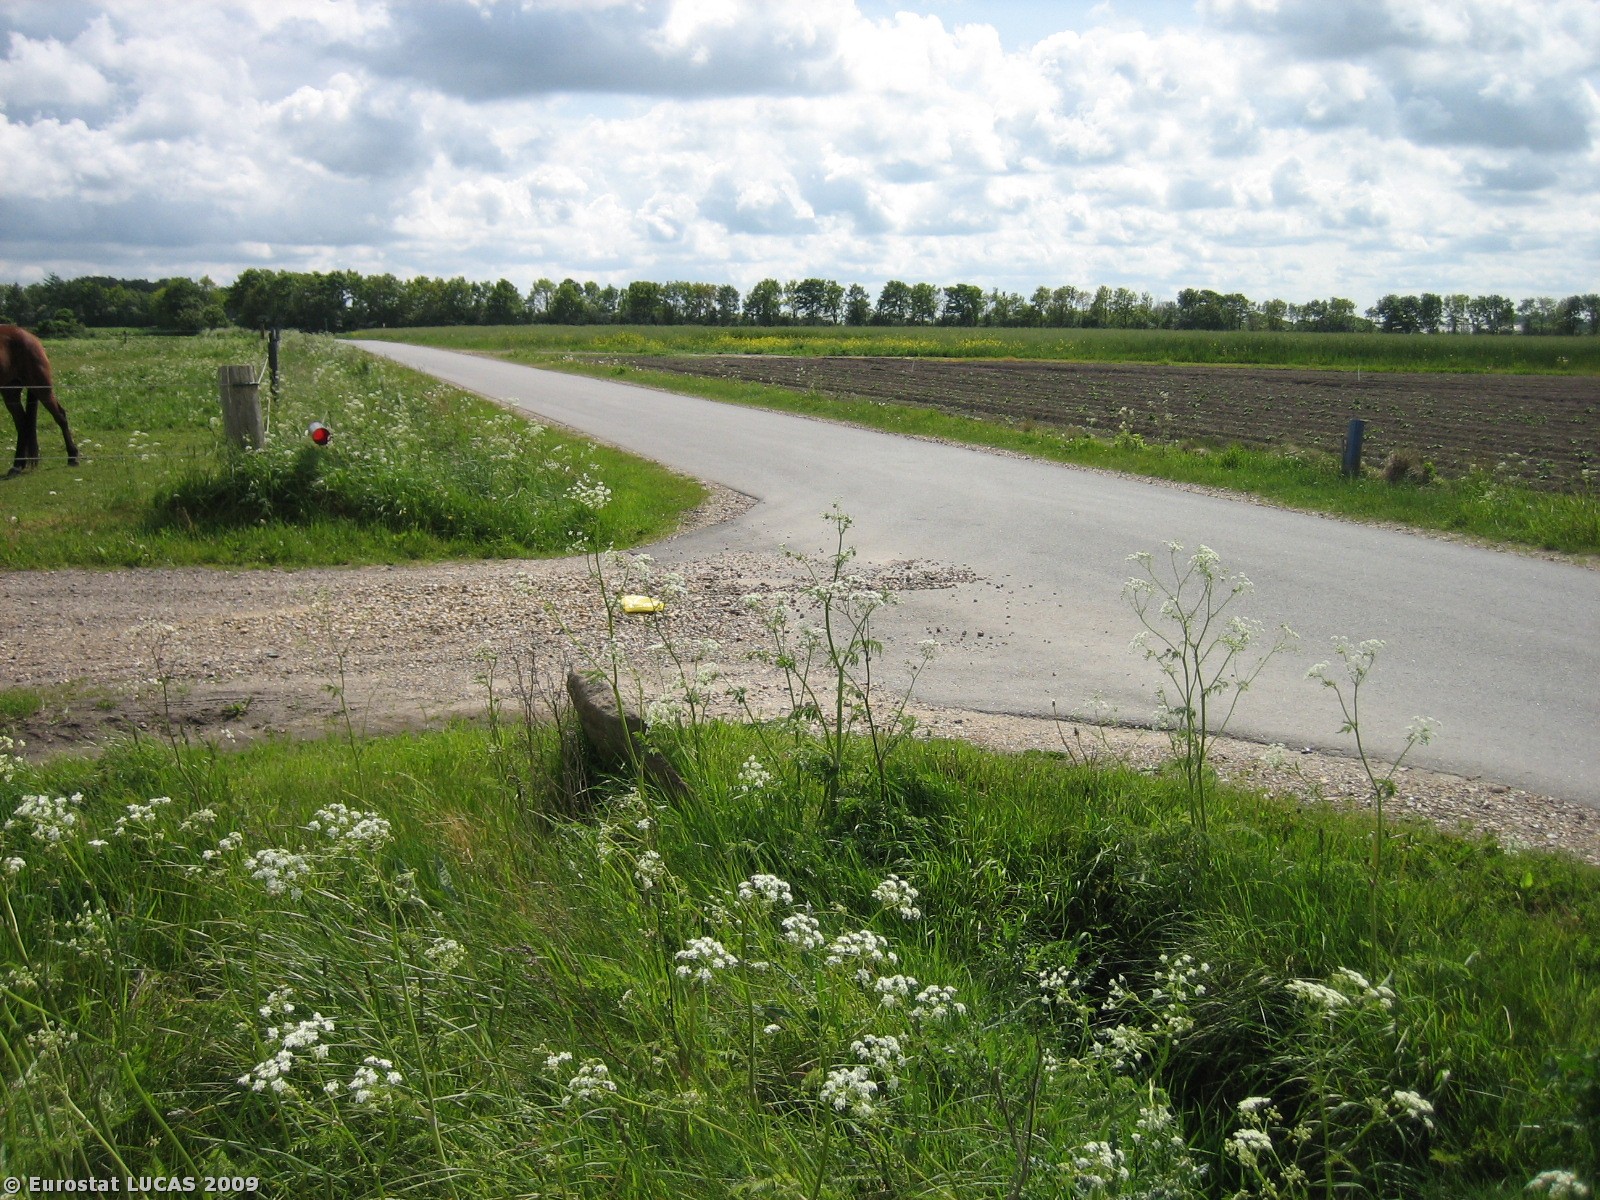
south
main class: Grassland
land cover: Grassland without tree/shrub cover
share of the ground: > 75 %
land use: Unused
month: May
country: DK
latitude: 55.9850
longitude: 8.8632
